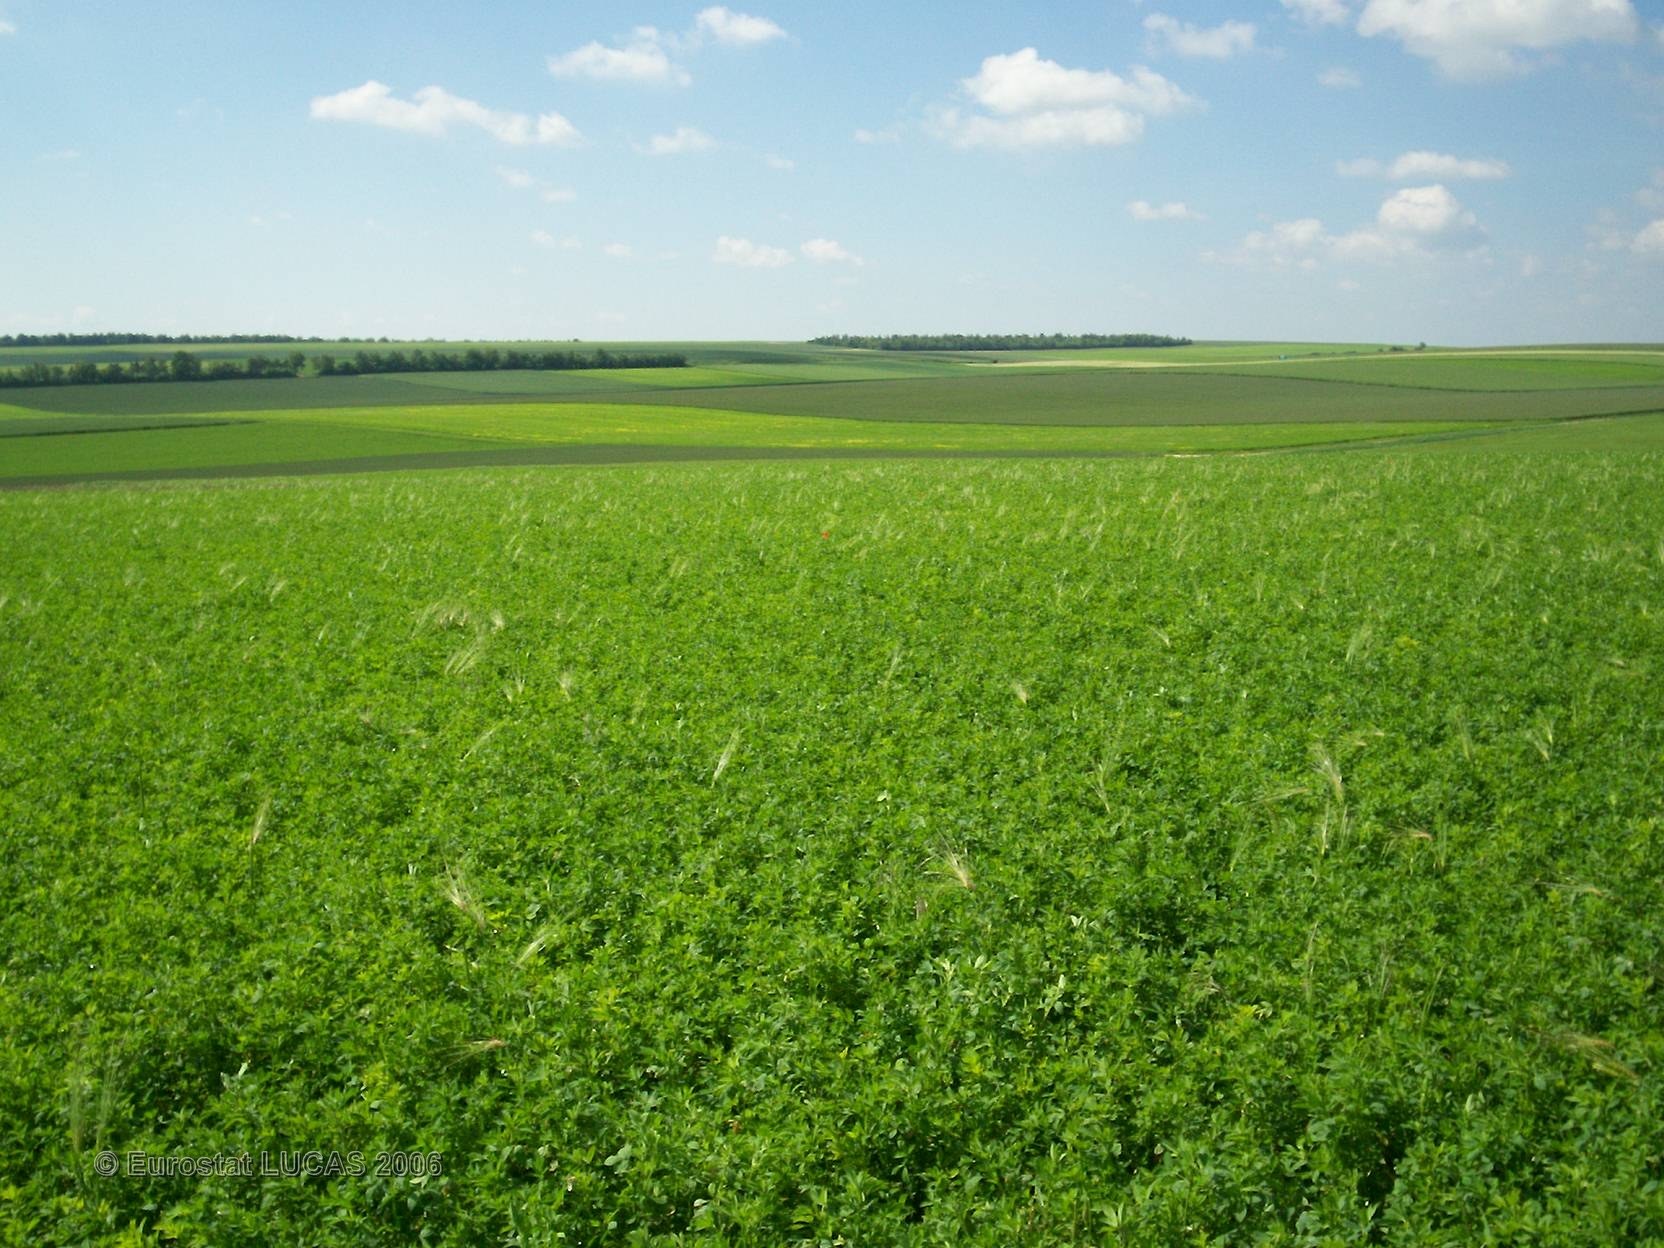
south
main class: Cropland
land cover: Lucerne
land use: Agriculture (excluding fallow land and kitchen gardens)
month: June
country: FR
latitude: 48.8040
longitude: 4.4280
